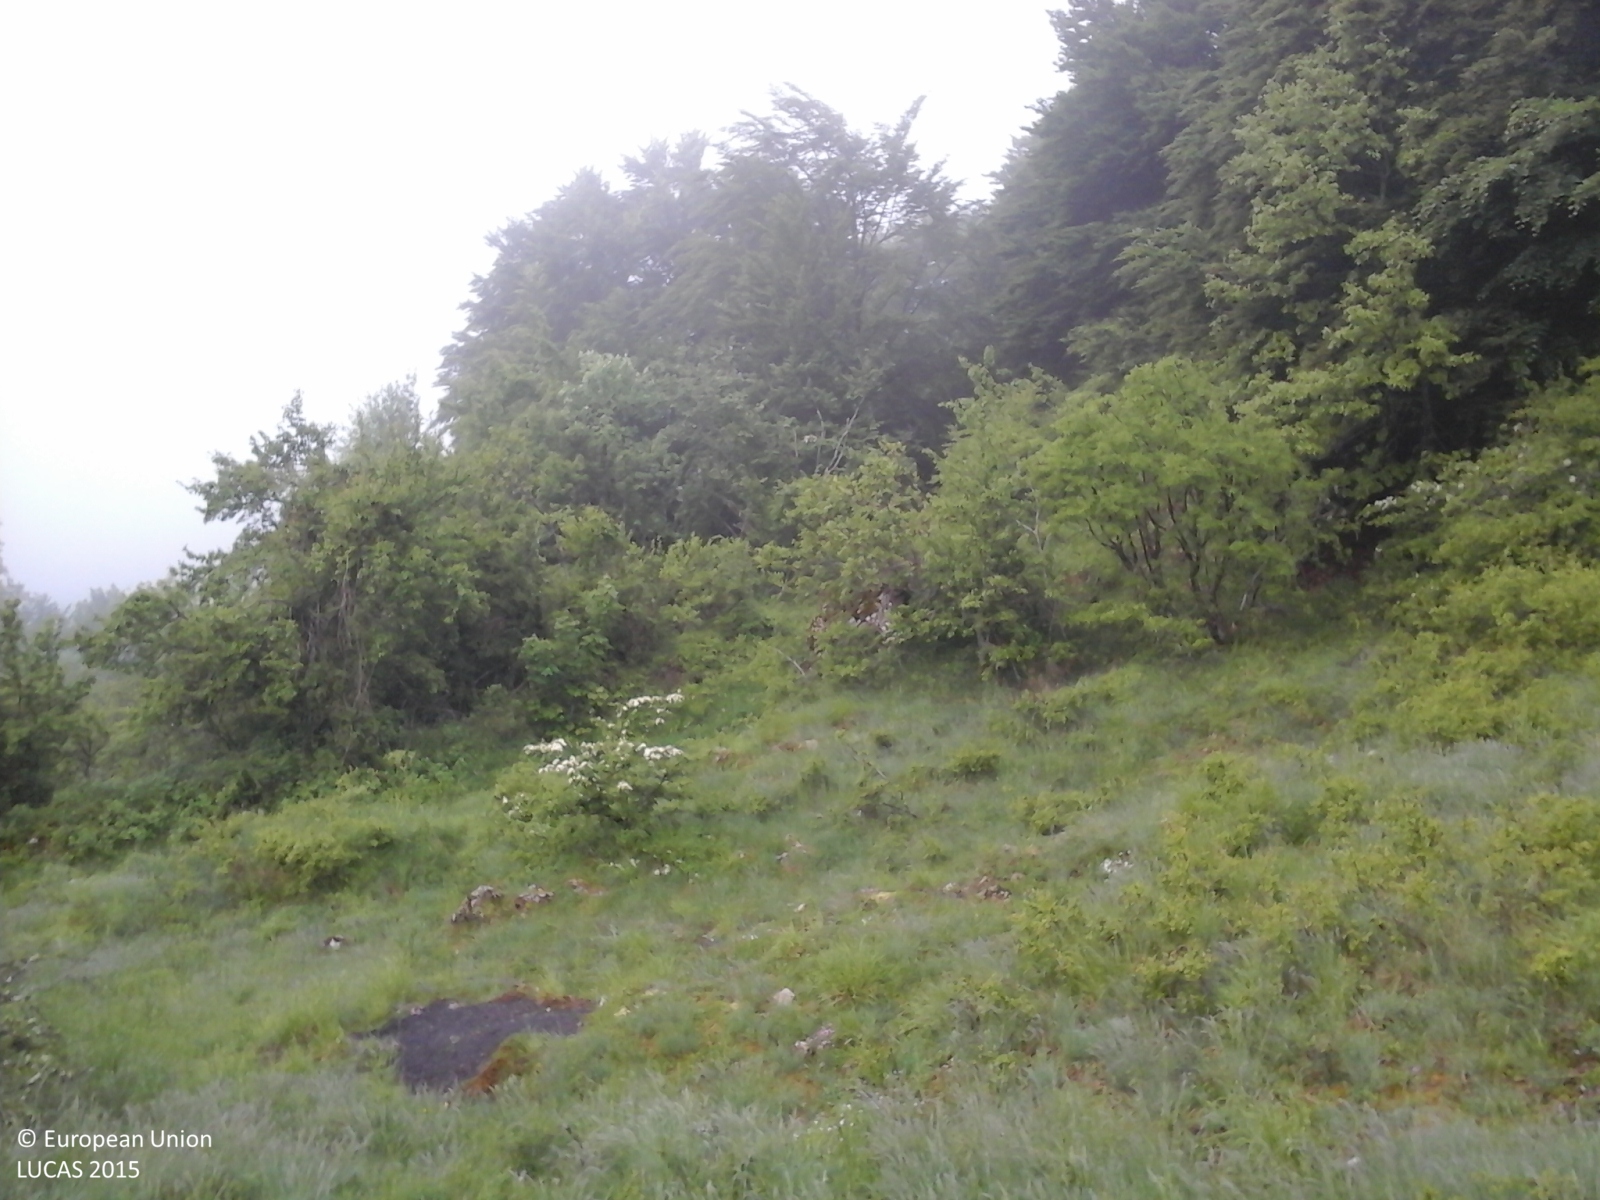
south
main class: Grassland
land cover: Grassland with sparse tree/shrub cover
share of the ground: > 75 %
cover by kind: herbaceous plants 90 %, broadleaved forest trees 5 %, shrubs 5 %
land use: Agriculture (excluding fallow land and kitchen gardens)
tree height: < 5 m
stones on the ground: 10 - 25 %
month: May
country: IT
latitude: 44.4407
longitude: 10.0125
